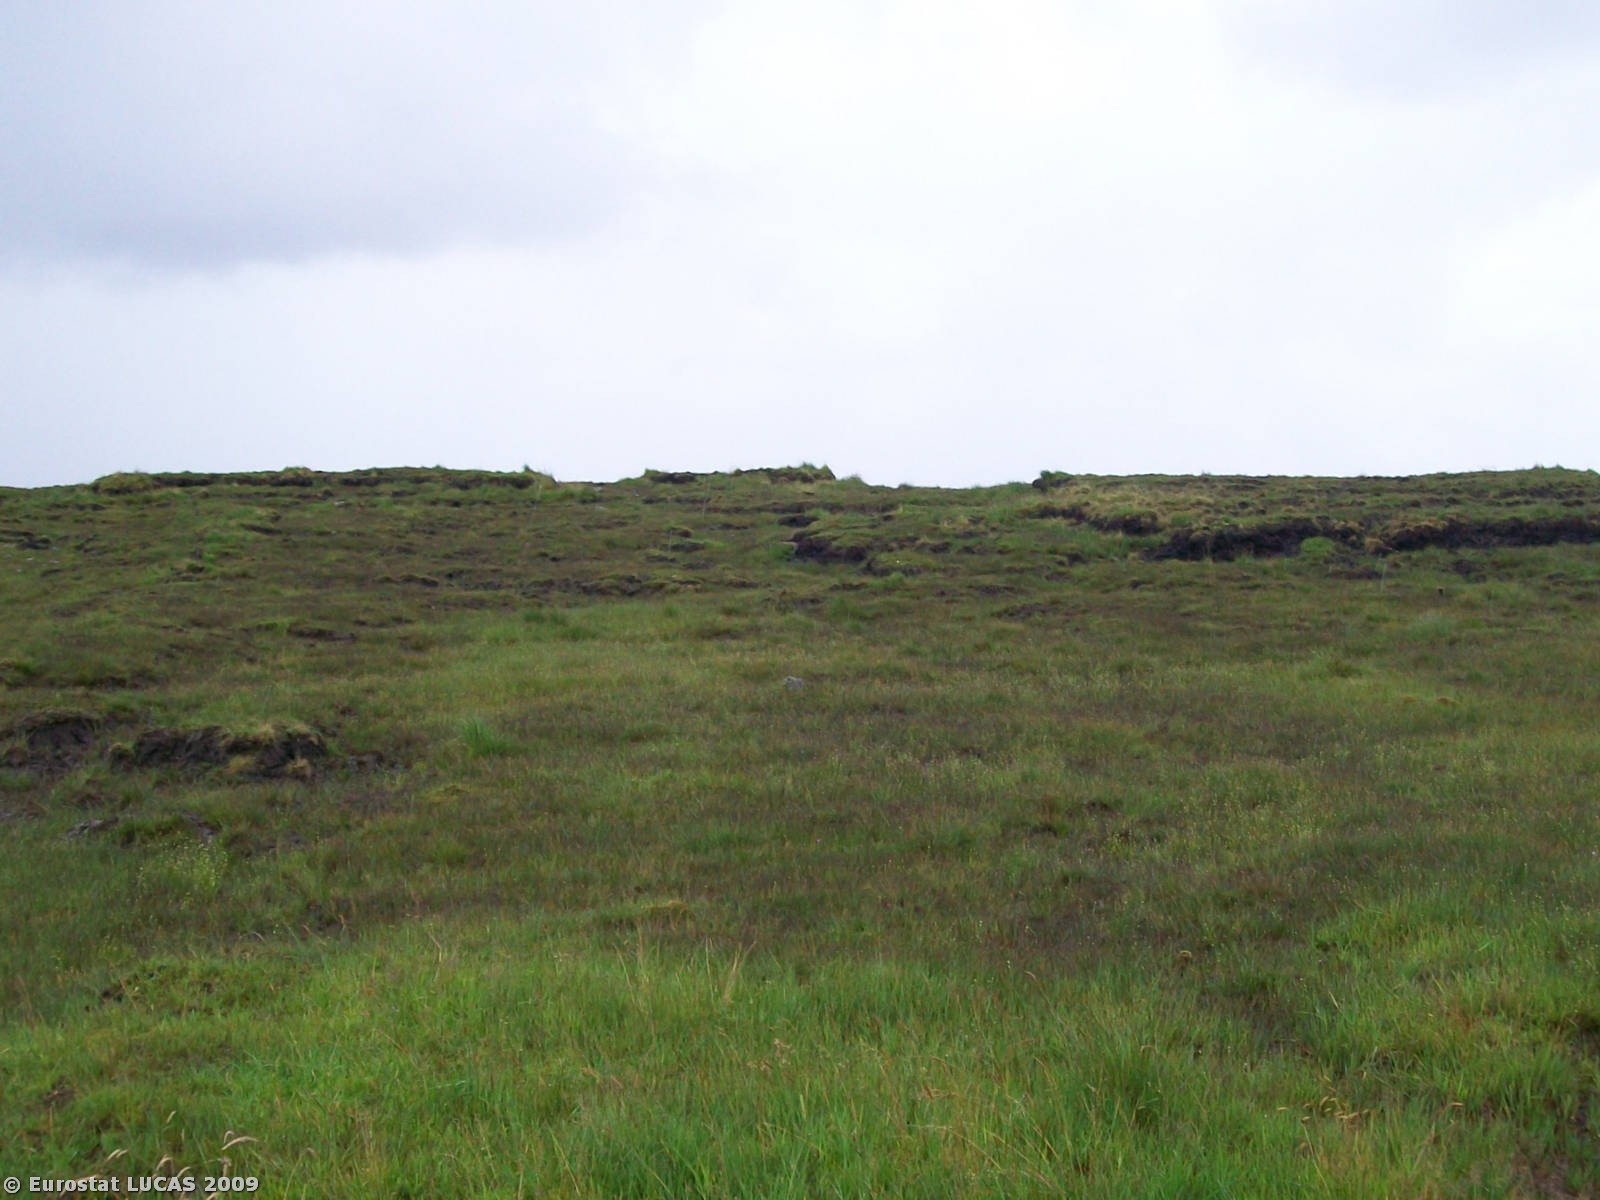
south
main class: Wetlands
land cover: Peatbogs
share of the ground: > 75 %
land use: Nature reserves
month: July
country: IE
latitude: 53.9192
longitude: -9.6516
